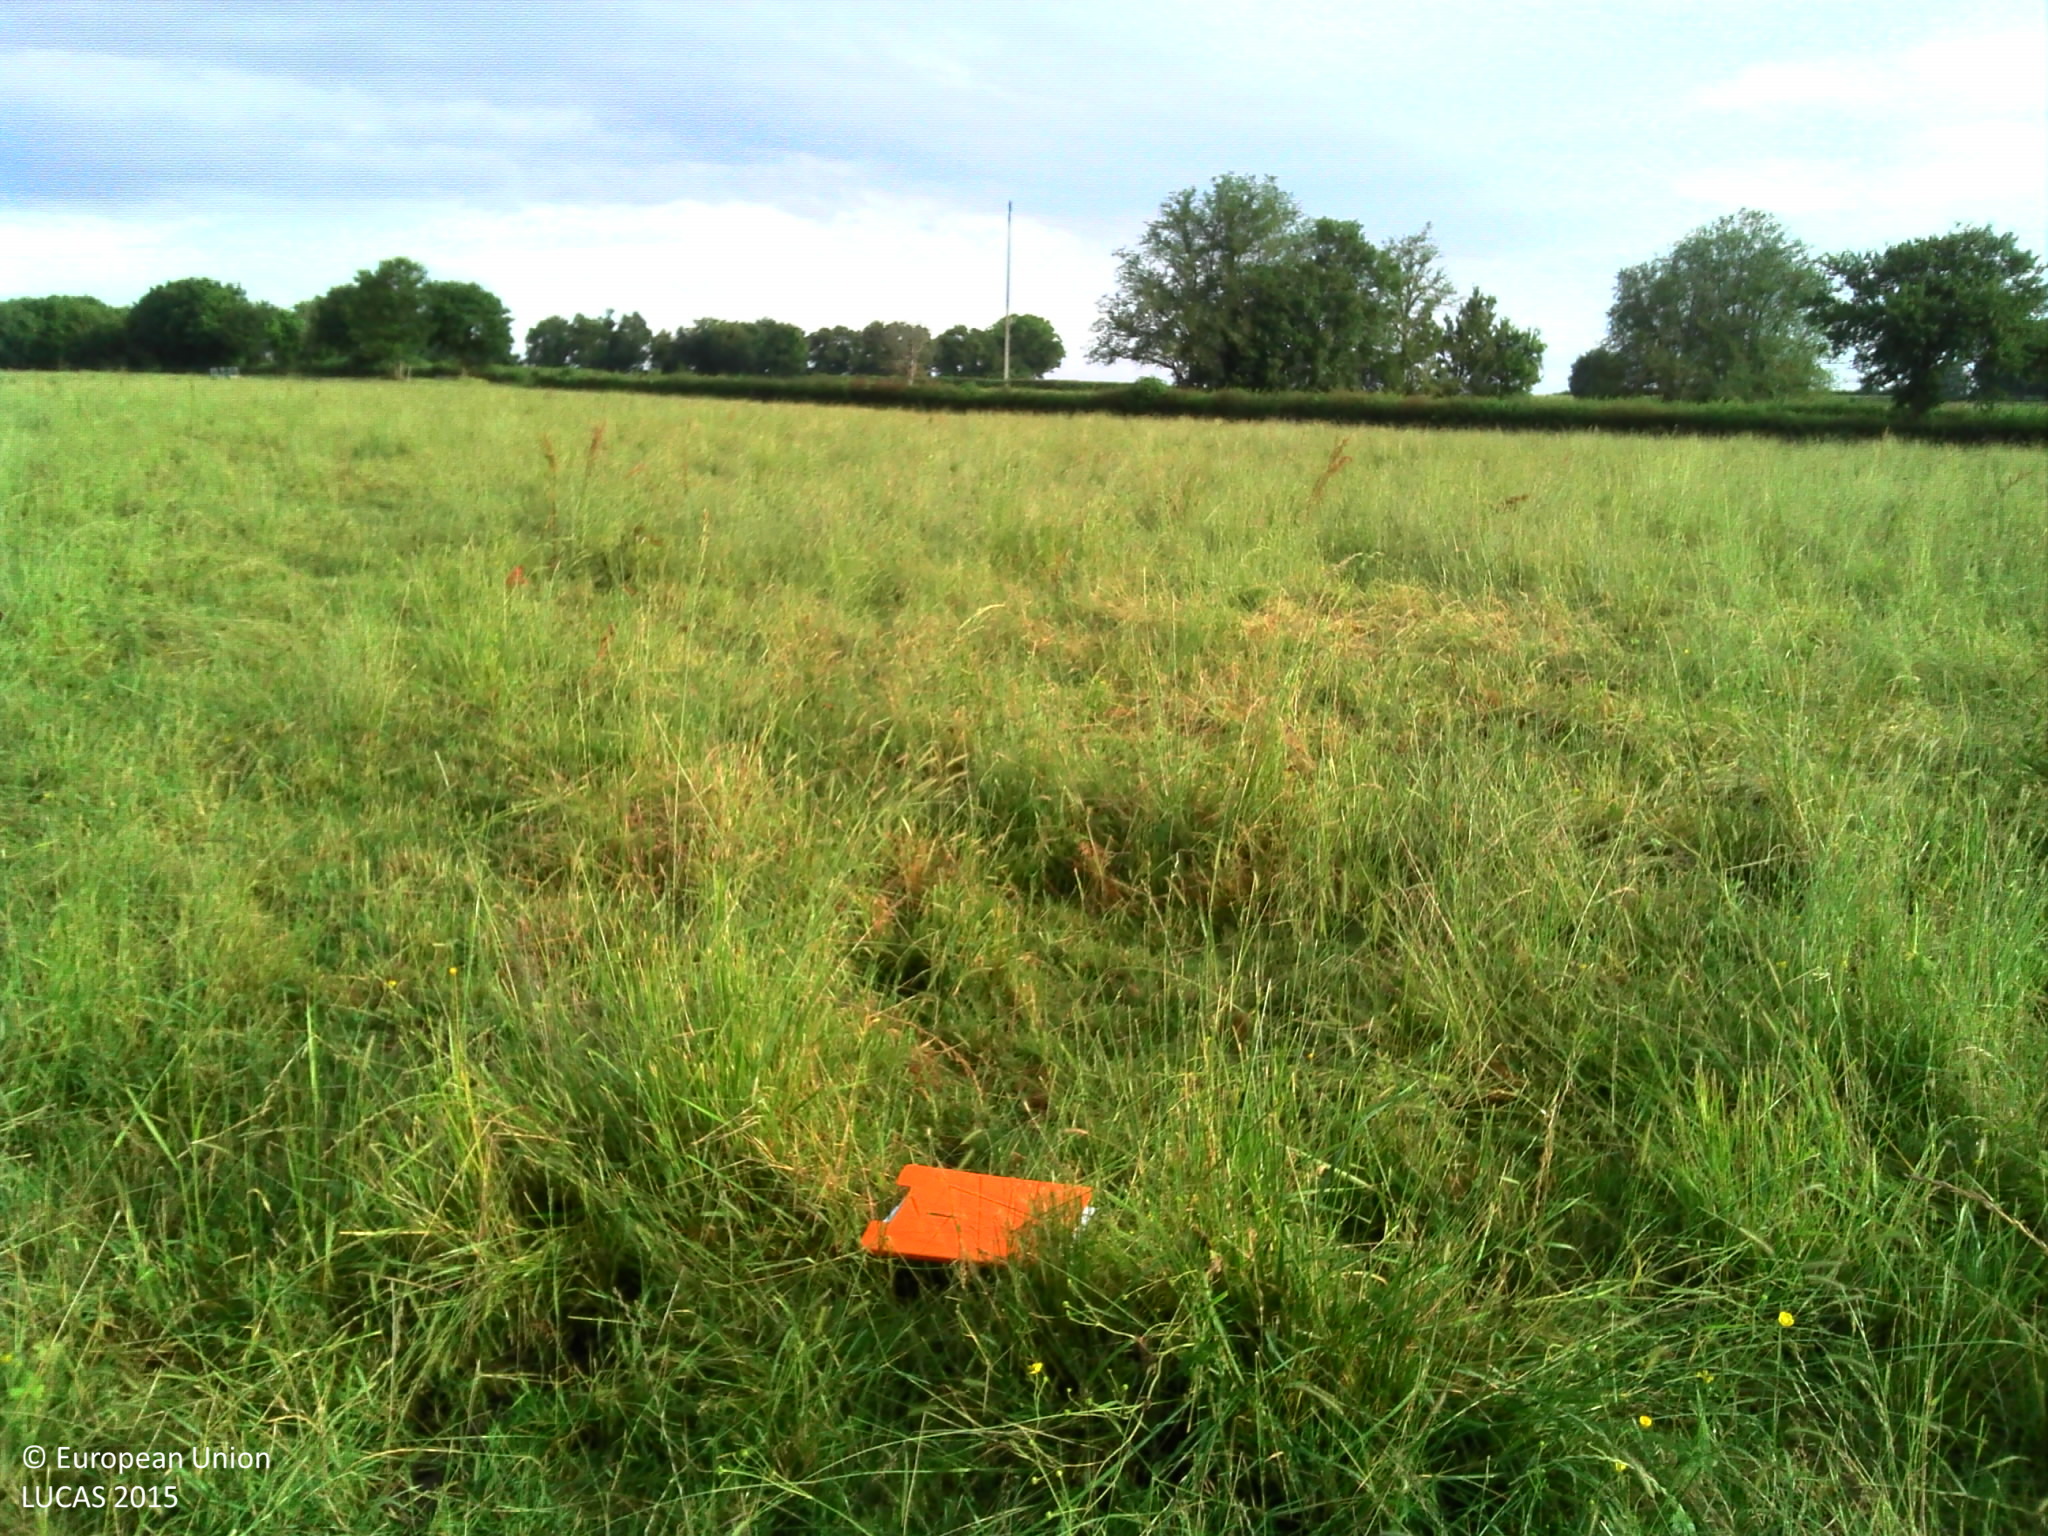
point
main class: Grassland
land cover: Grassland without tree/shrub cover
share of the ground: > 75 %
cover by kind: herbaceous plants 100 %
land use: Agriculture (excluding fallow land and kitchen gardens)
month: June
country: FR
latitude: 46.7151
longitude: 2.6824
